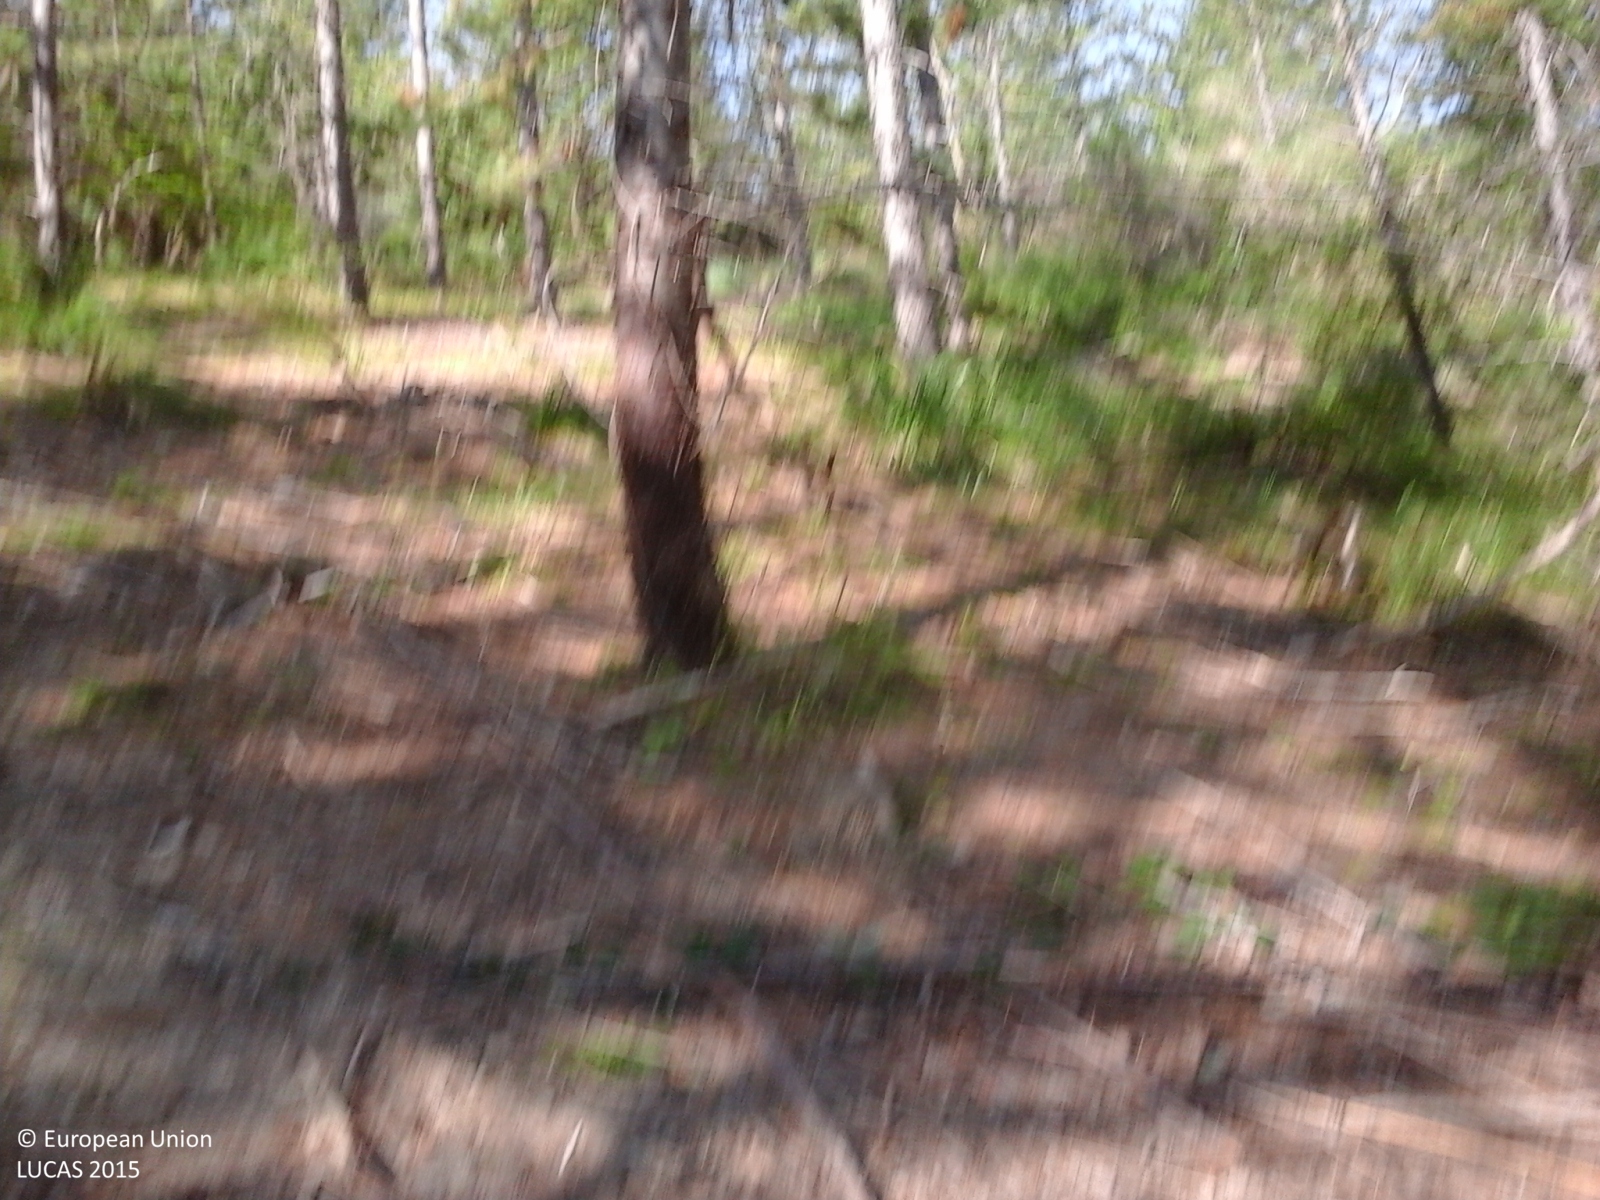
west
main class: Woodland
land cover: Pine dominated mixed woodland
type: coniferous forest of the mediterranean region
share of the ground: 50 - 75 %
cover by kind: coniferous forest trees 60 %, broadleaved forest trees 20 %, shrubs 10 %, herbaceous plants 10 %
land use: Forestry
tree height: > 5 m
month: July
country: IT
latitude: 42.9488
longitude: 11.5762
